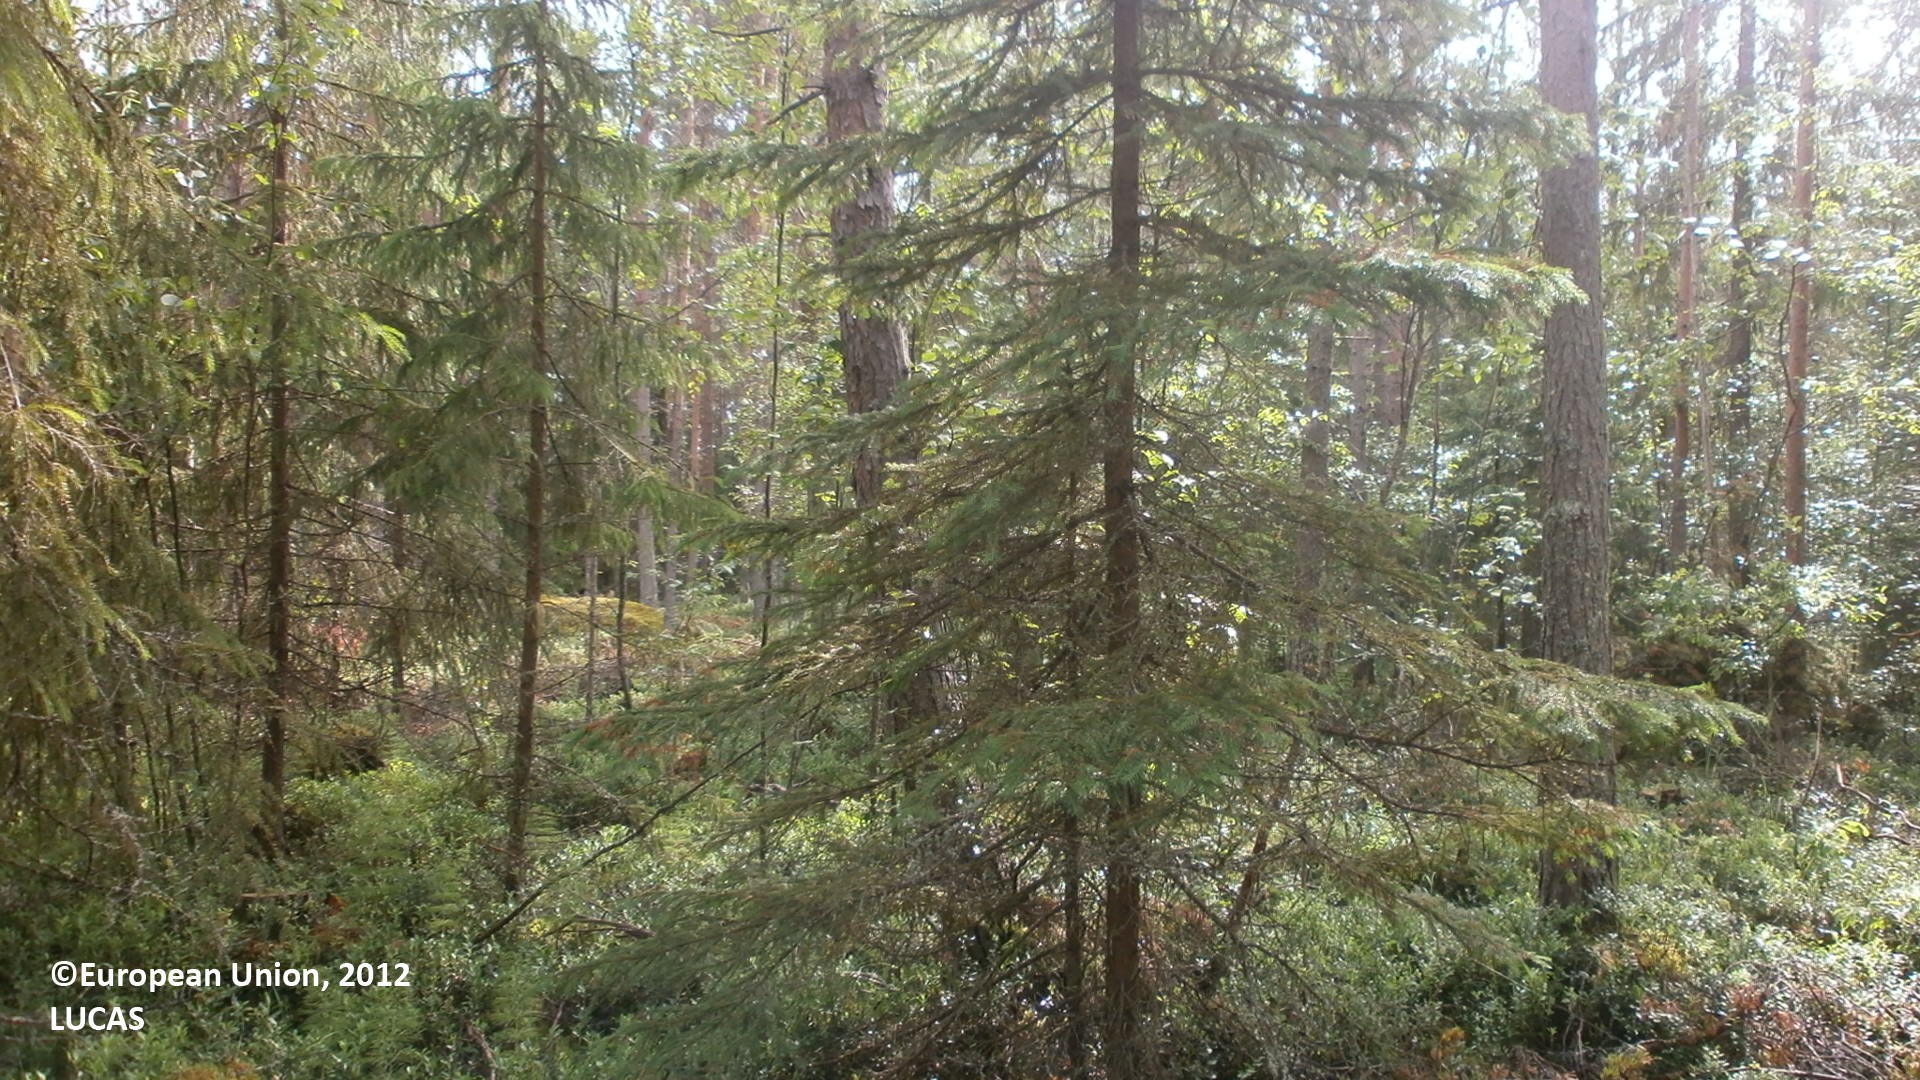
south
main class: Woodland
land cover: Pine dominated coniferous woodland
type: boreal forest
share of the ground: 50 - 75 %
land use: Forestry
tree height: > 5 m
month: July
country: FI
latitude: 64.4953
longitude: 24.3665
